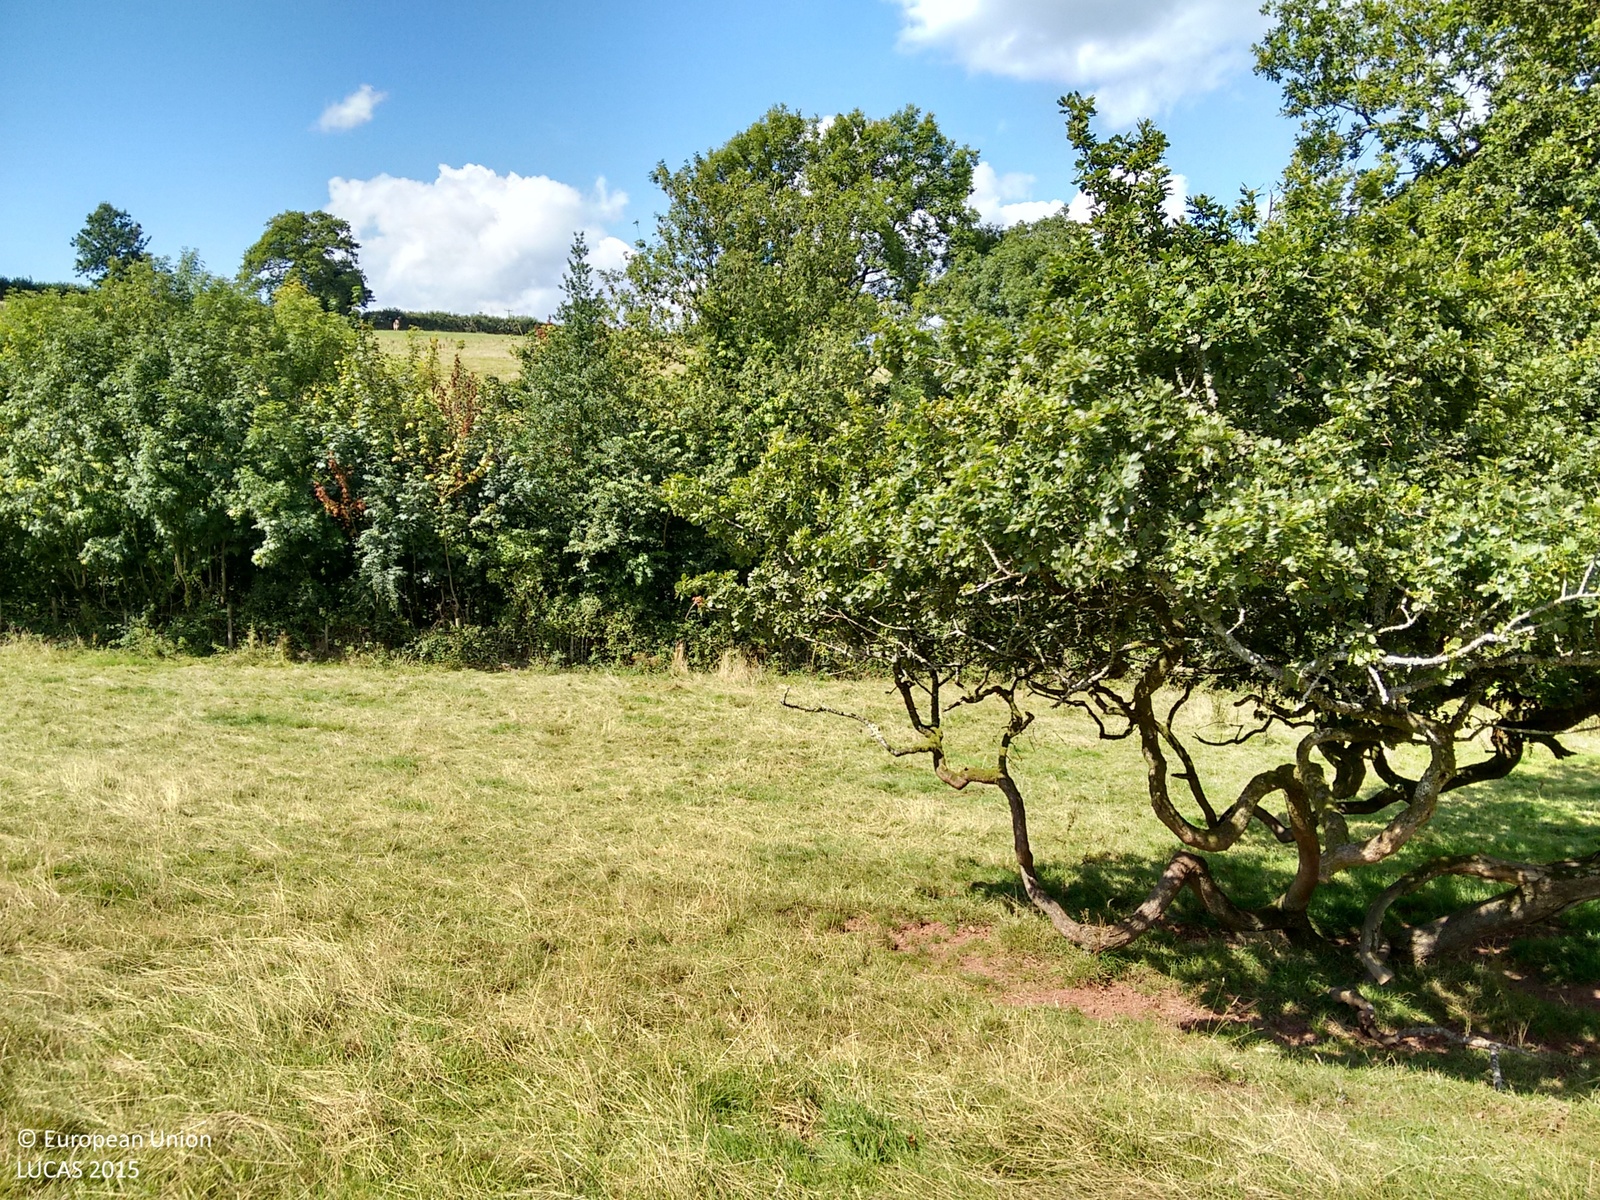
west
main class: Grassland
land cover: Grassland with sparse tree/shrub cover
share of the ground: > 75 %
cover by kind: herbaceous plants 95 %, broadleaved forest trees 5 %
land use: Agriculture (excluding fallow land and kitchen gardens)
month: August
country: GB
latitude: 51.7878
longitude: -4.3826
